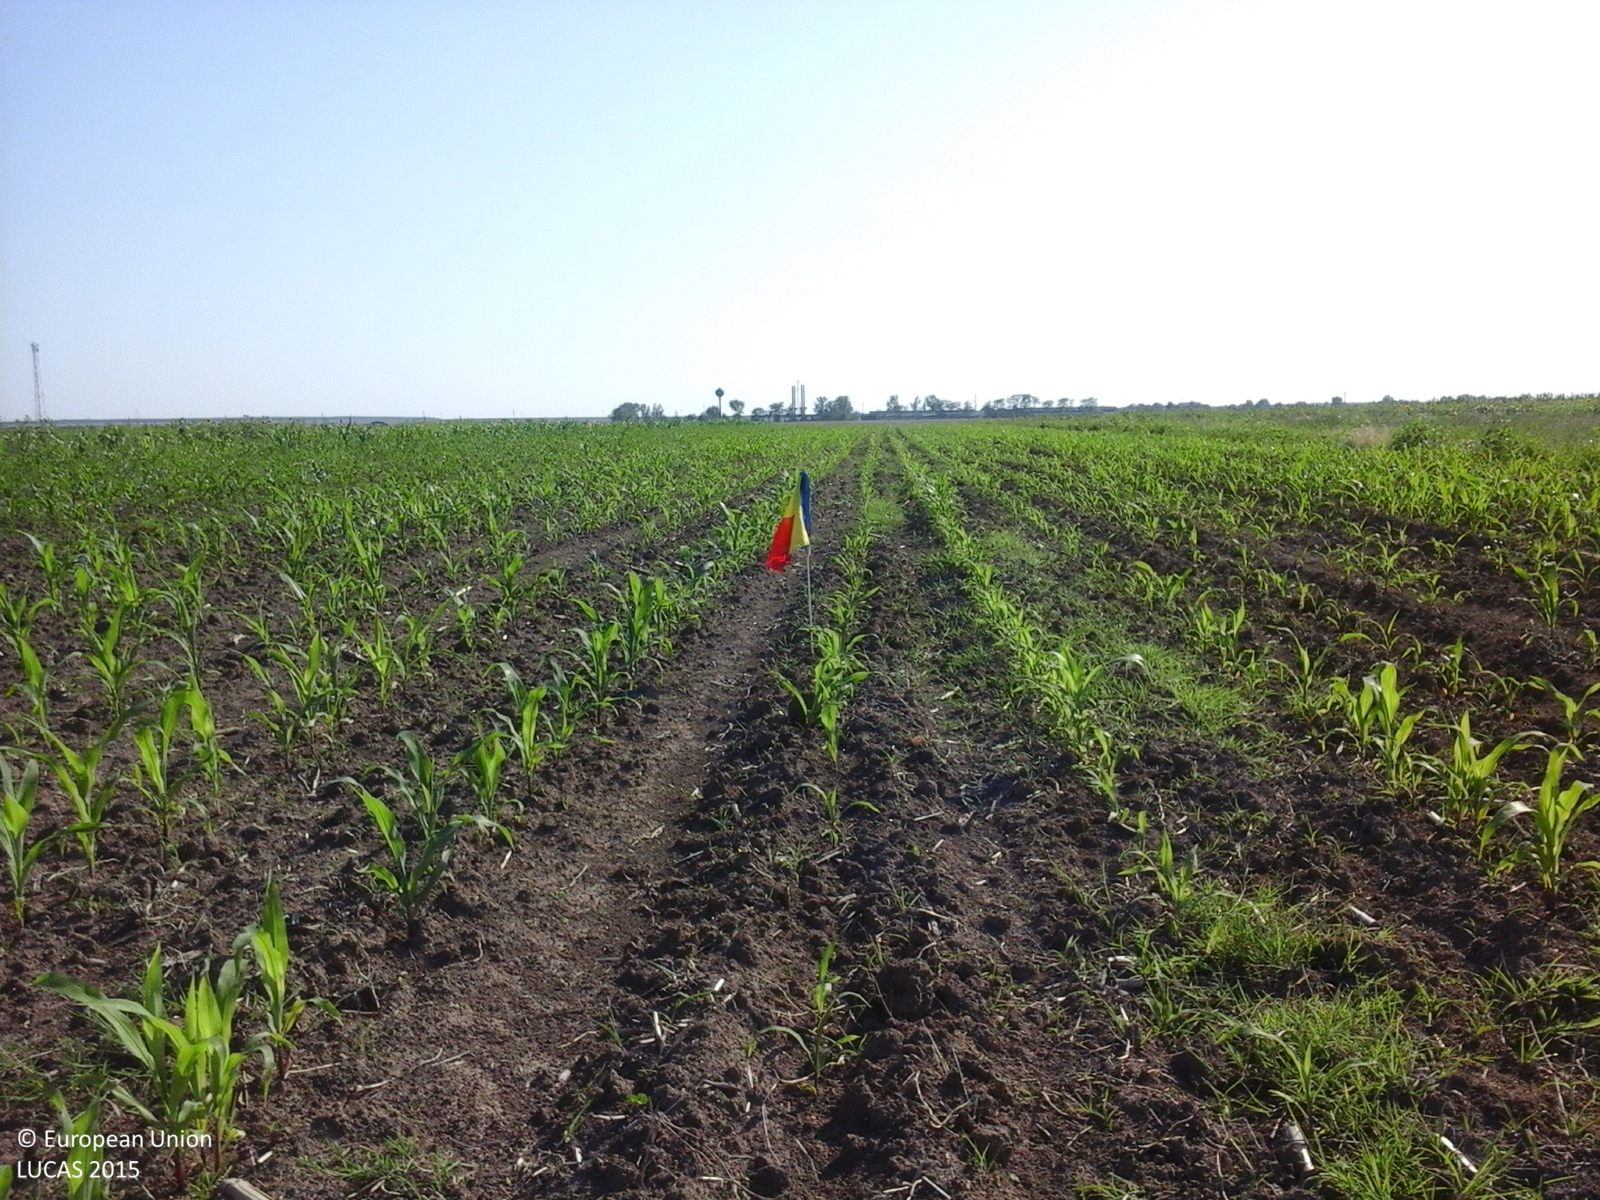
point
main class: Cropland
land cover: Maize
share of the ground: 10 - 25 %
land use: Agriculture (excluding fallow land and kitchen gardens)
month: July
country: RO
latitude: 44.3636
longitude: 24.6661
